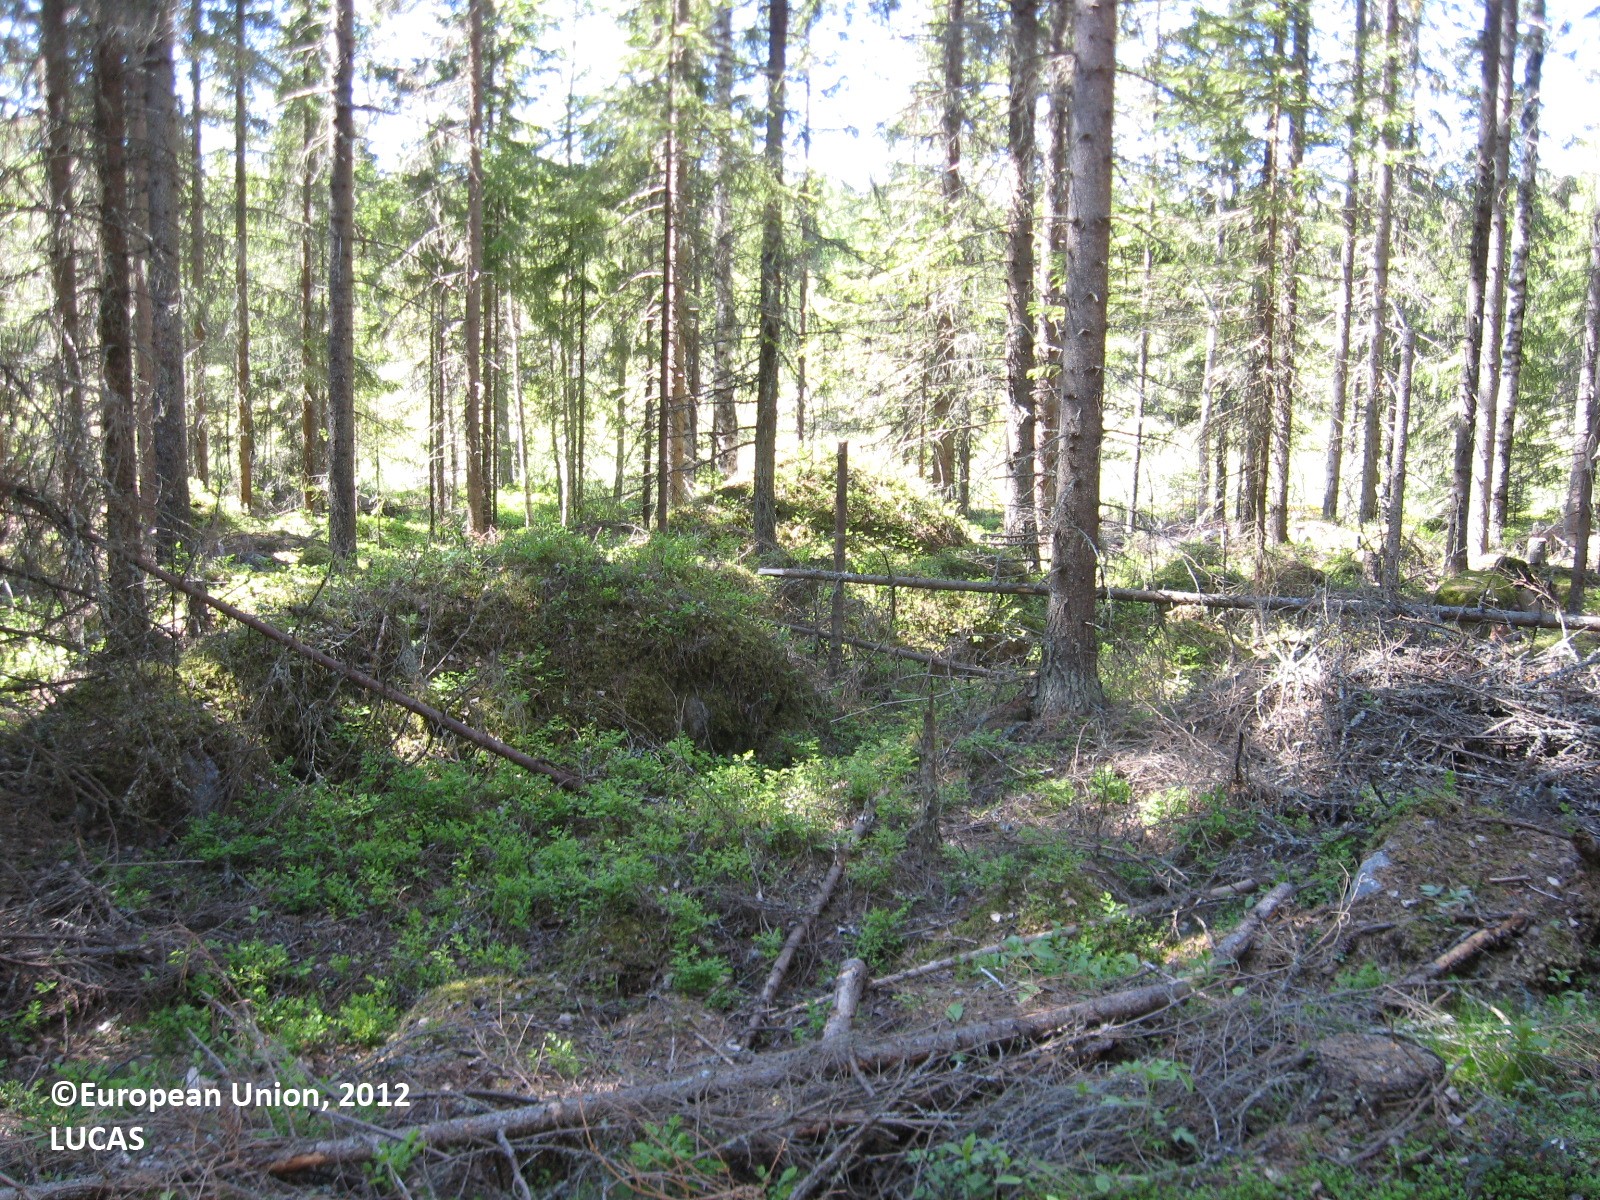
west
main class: Woodland
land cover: Spruce dominated coniferous woodland
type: boreal forest
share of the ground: > 75 %
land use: Forestry
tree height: > 5 m
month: June
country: FI
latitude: 63.2573
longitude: 21.8534
